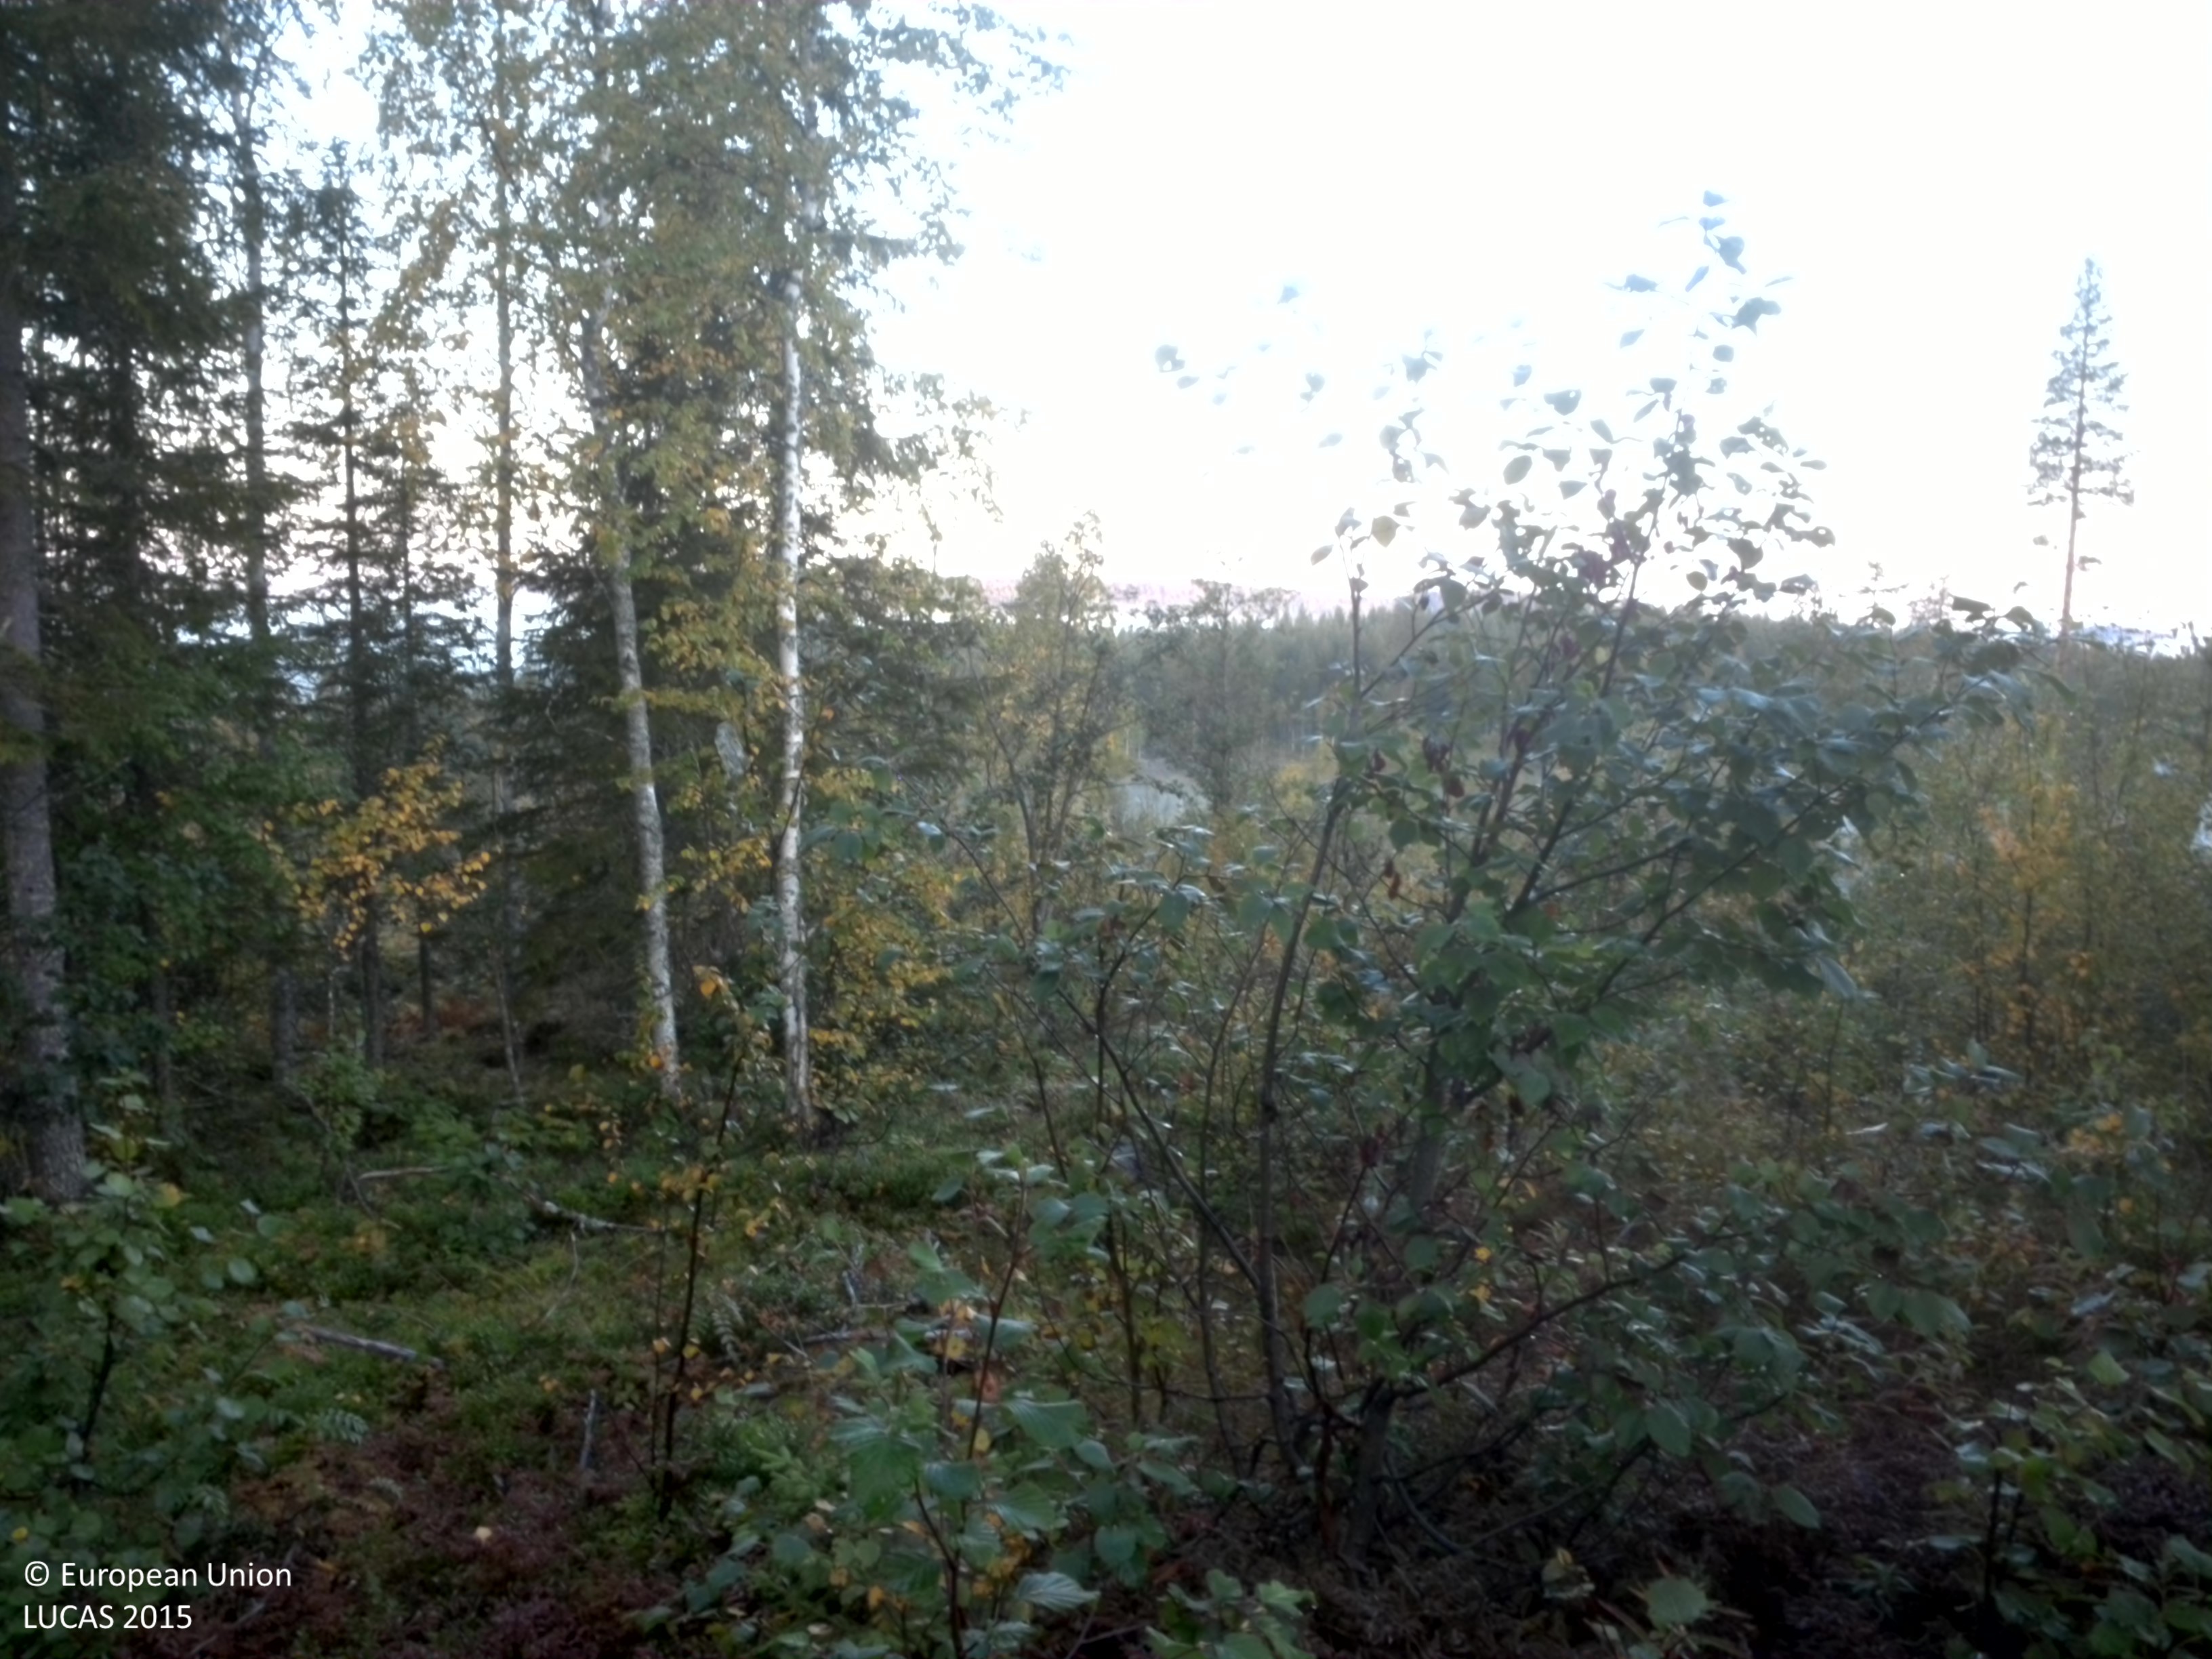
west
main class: Woodland
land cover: Broadleaved woodland
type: boreal forest
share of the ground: 50 - 75 %
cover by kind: broadleaved forest trees 55 %, coniferous forest trees 15 %, shrubs 15 %, herbaceous plants 15 %
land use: Forestry
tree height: < 5 m
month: September
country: SE
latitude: 64.4229
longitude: 20.0854
